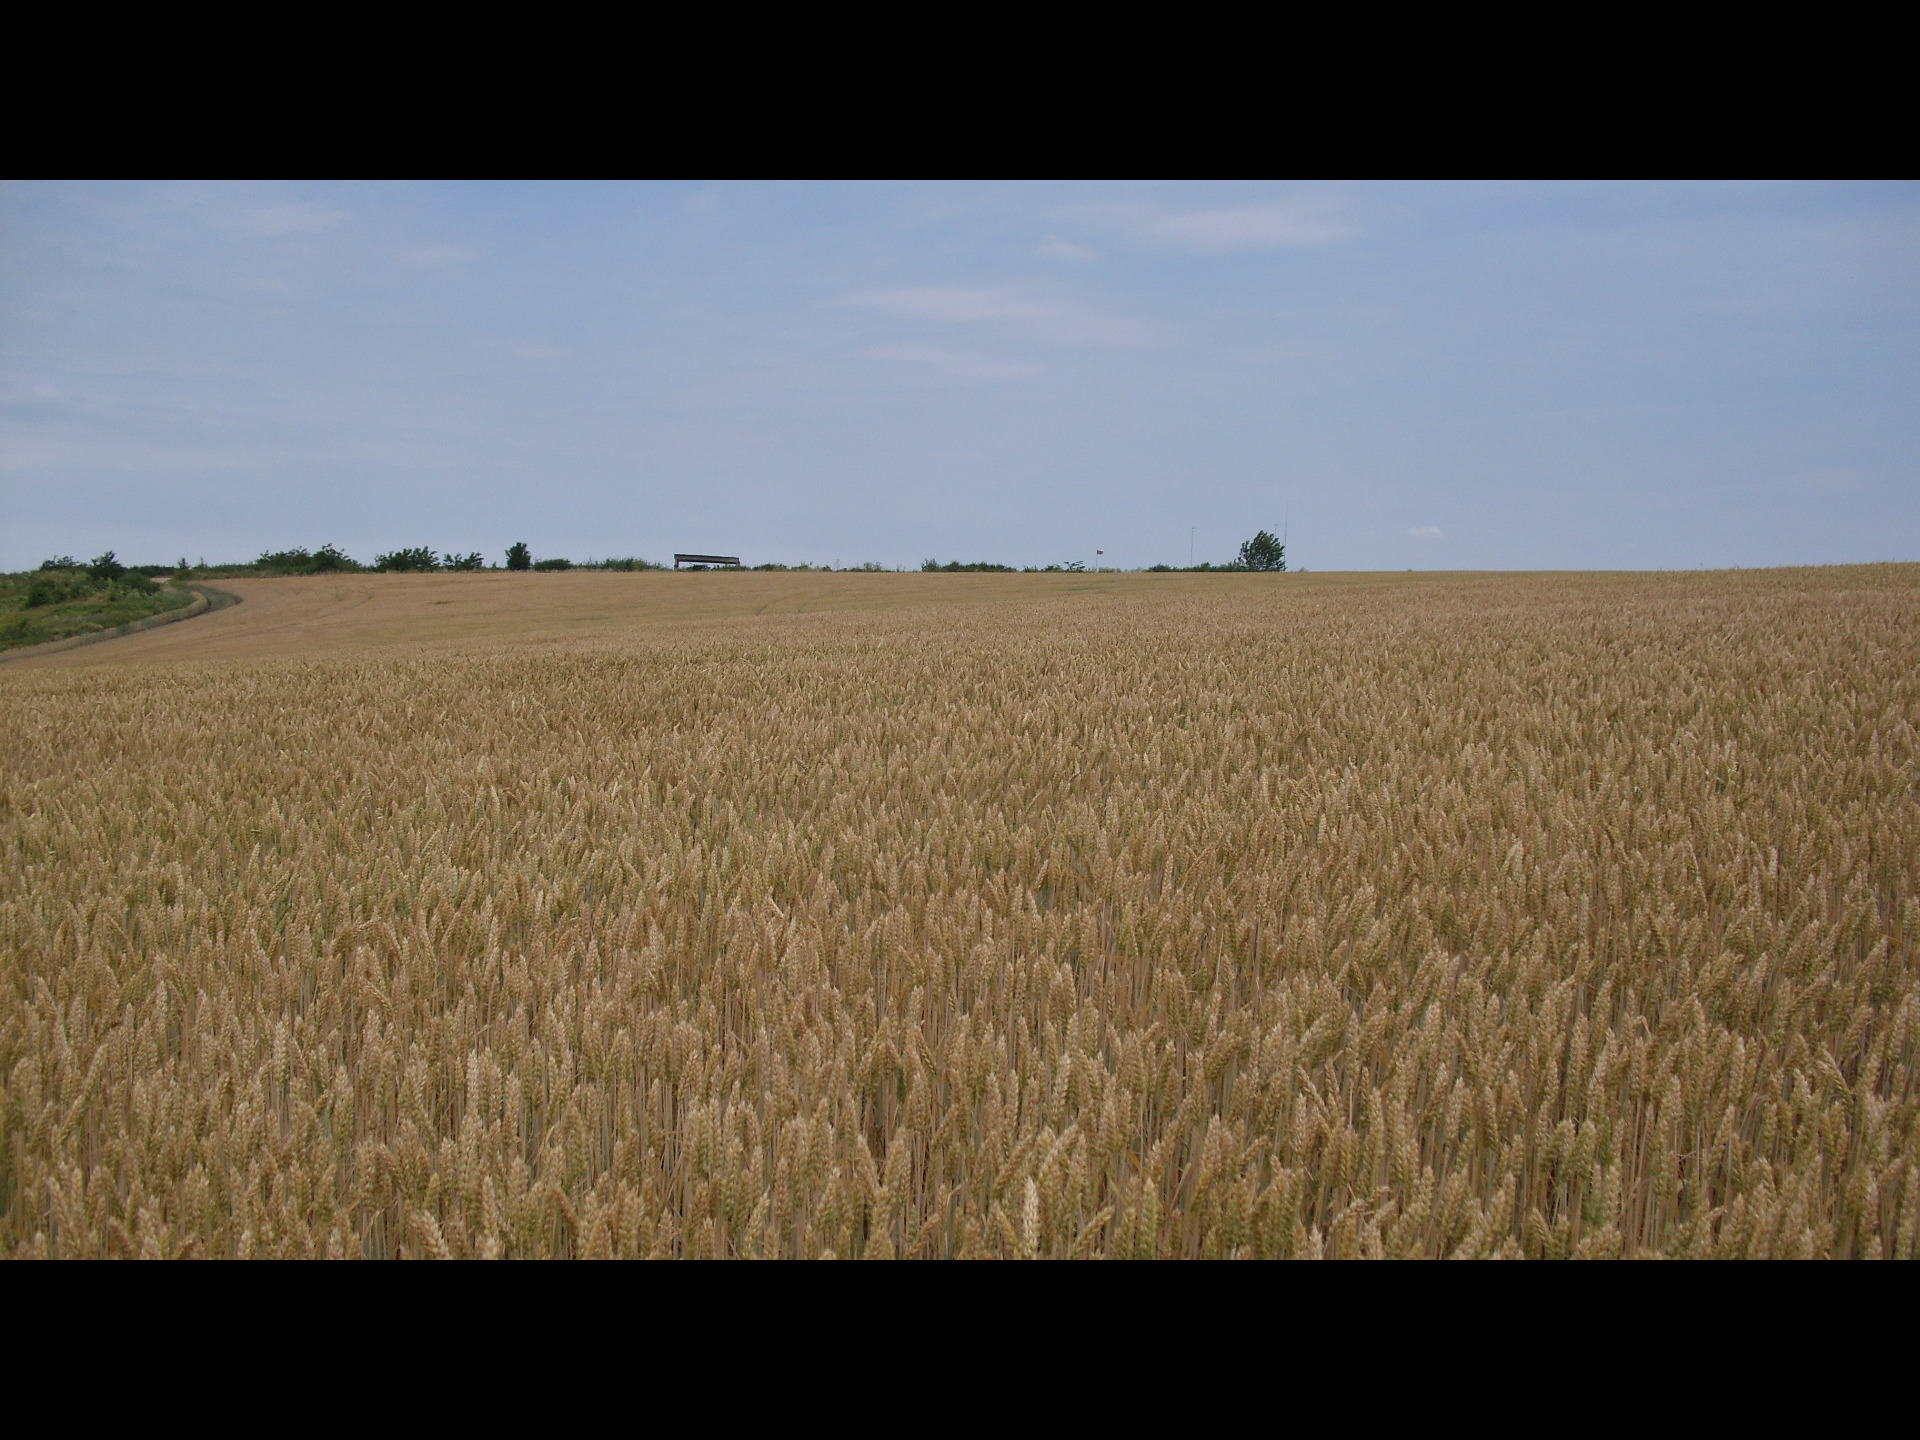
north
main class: Cropland
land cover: Common wheat
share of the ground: > 75 %
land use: Agriculture (excluding fallow land and kitchen gardens)
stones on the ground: < 10 %
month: June
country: BG
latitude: 43.3713
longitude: 23.5079
